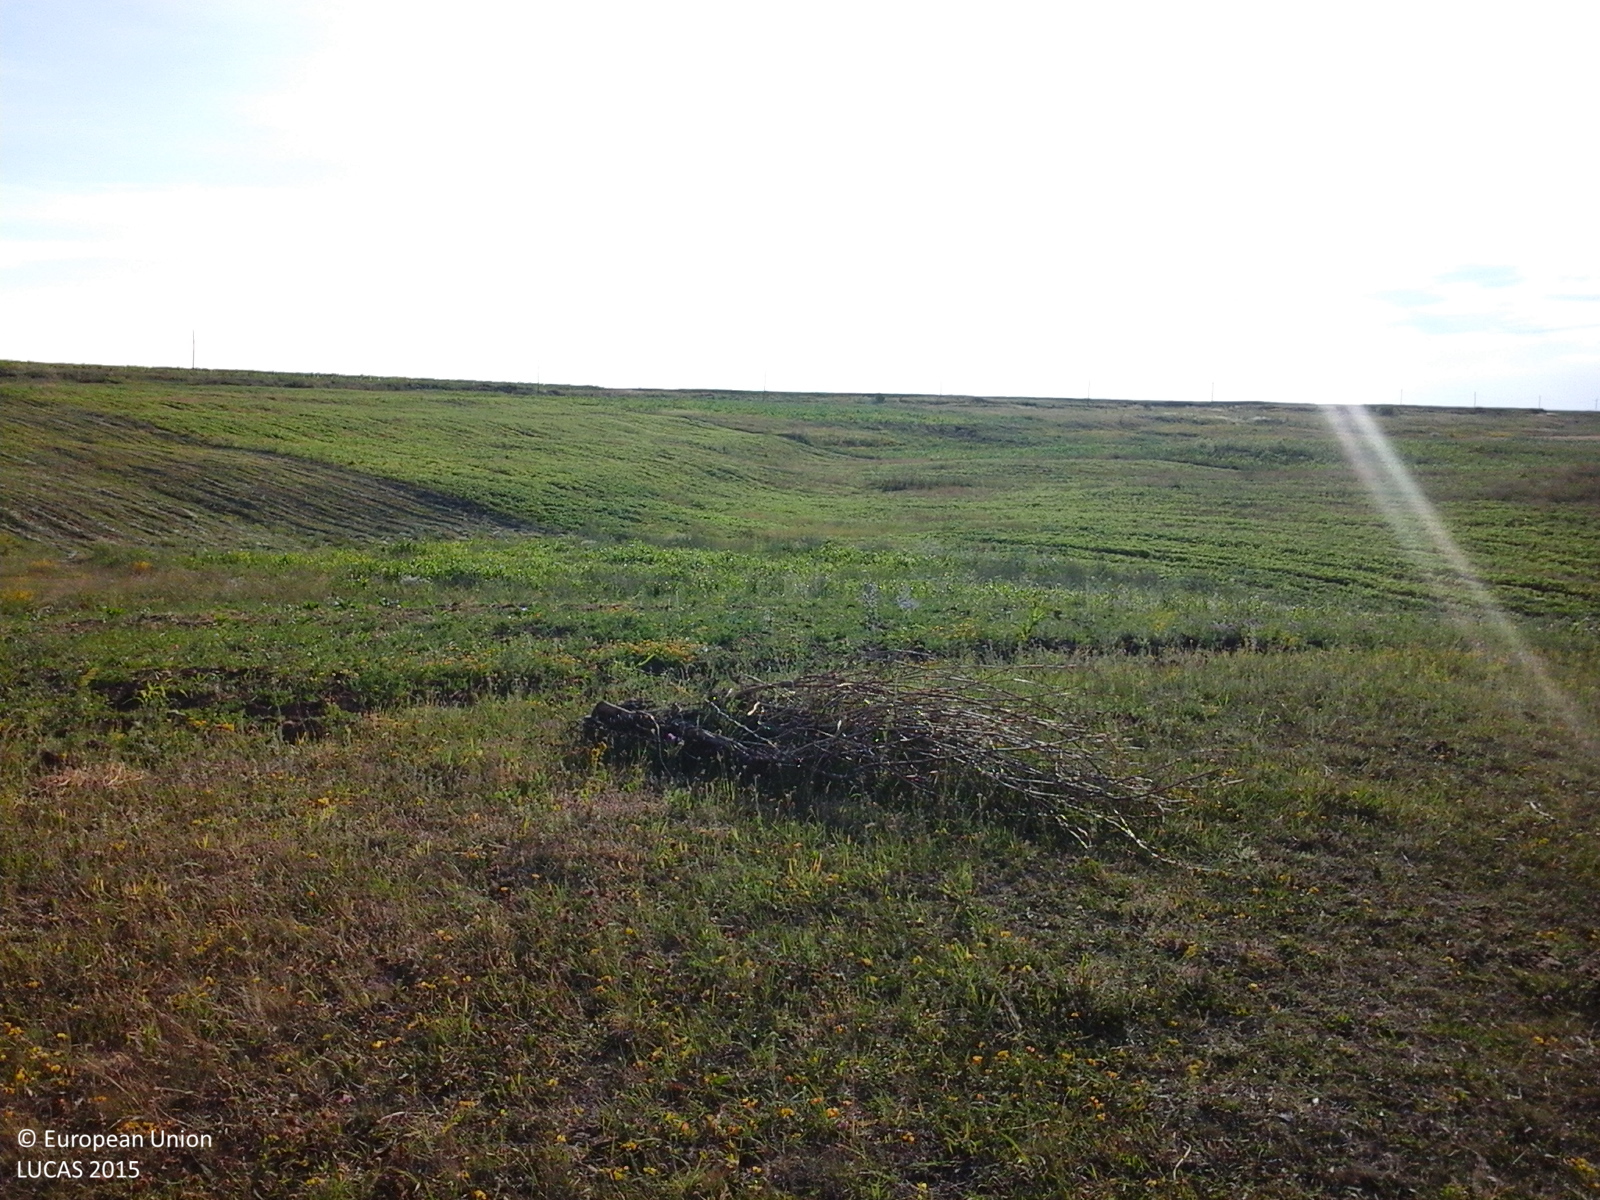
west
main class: Grassland
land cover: Grassland without tree/shrub cover
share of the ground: > 75 %
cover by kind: herbaceous plants 100 %
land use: Agriculture (excluding fallow land and kitchen gardens)
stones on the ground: < 10 %
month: June
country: RO
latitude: 48.0224
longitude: 26.9321
